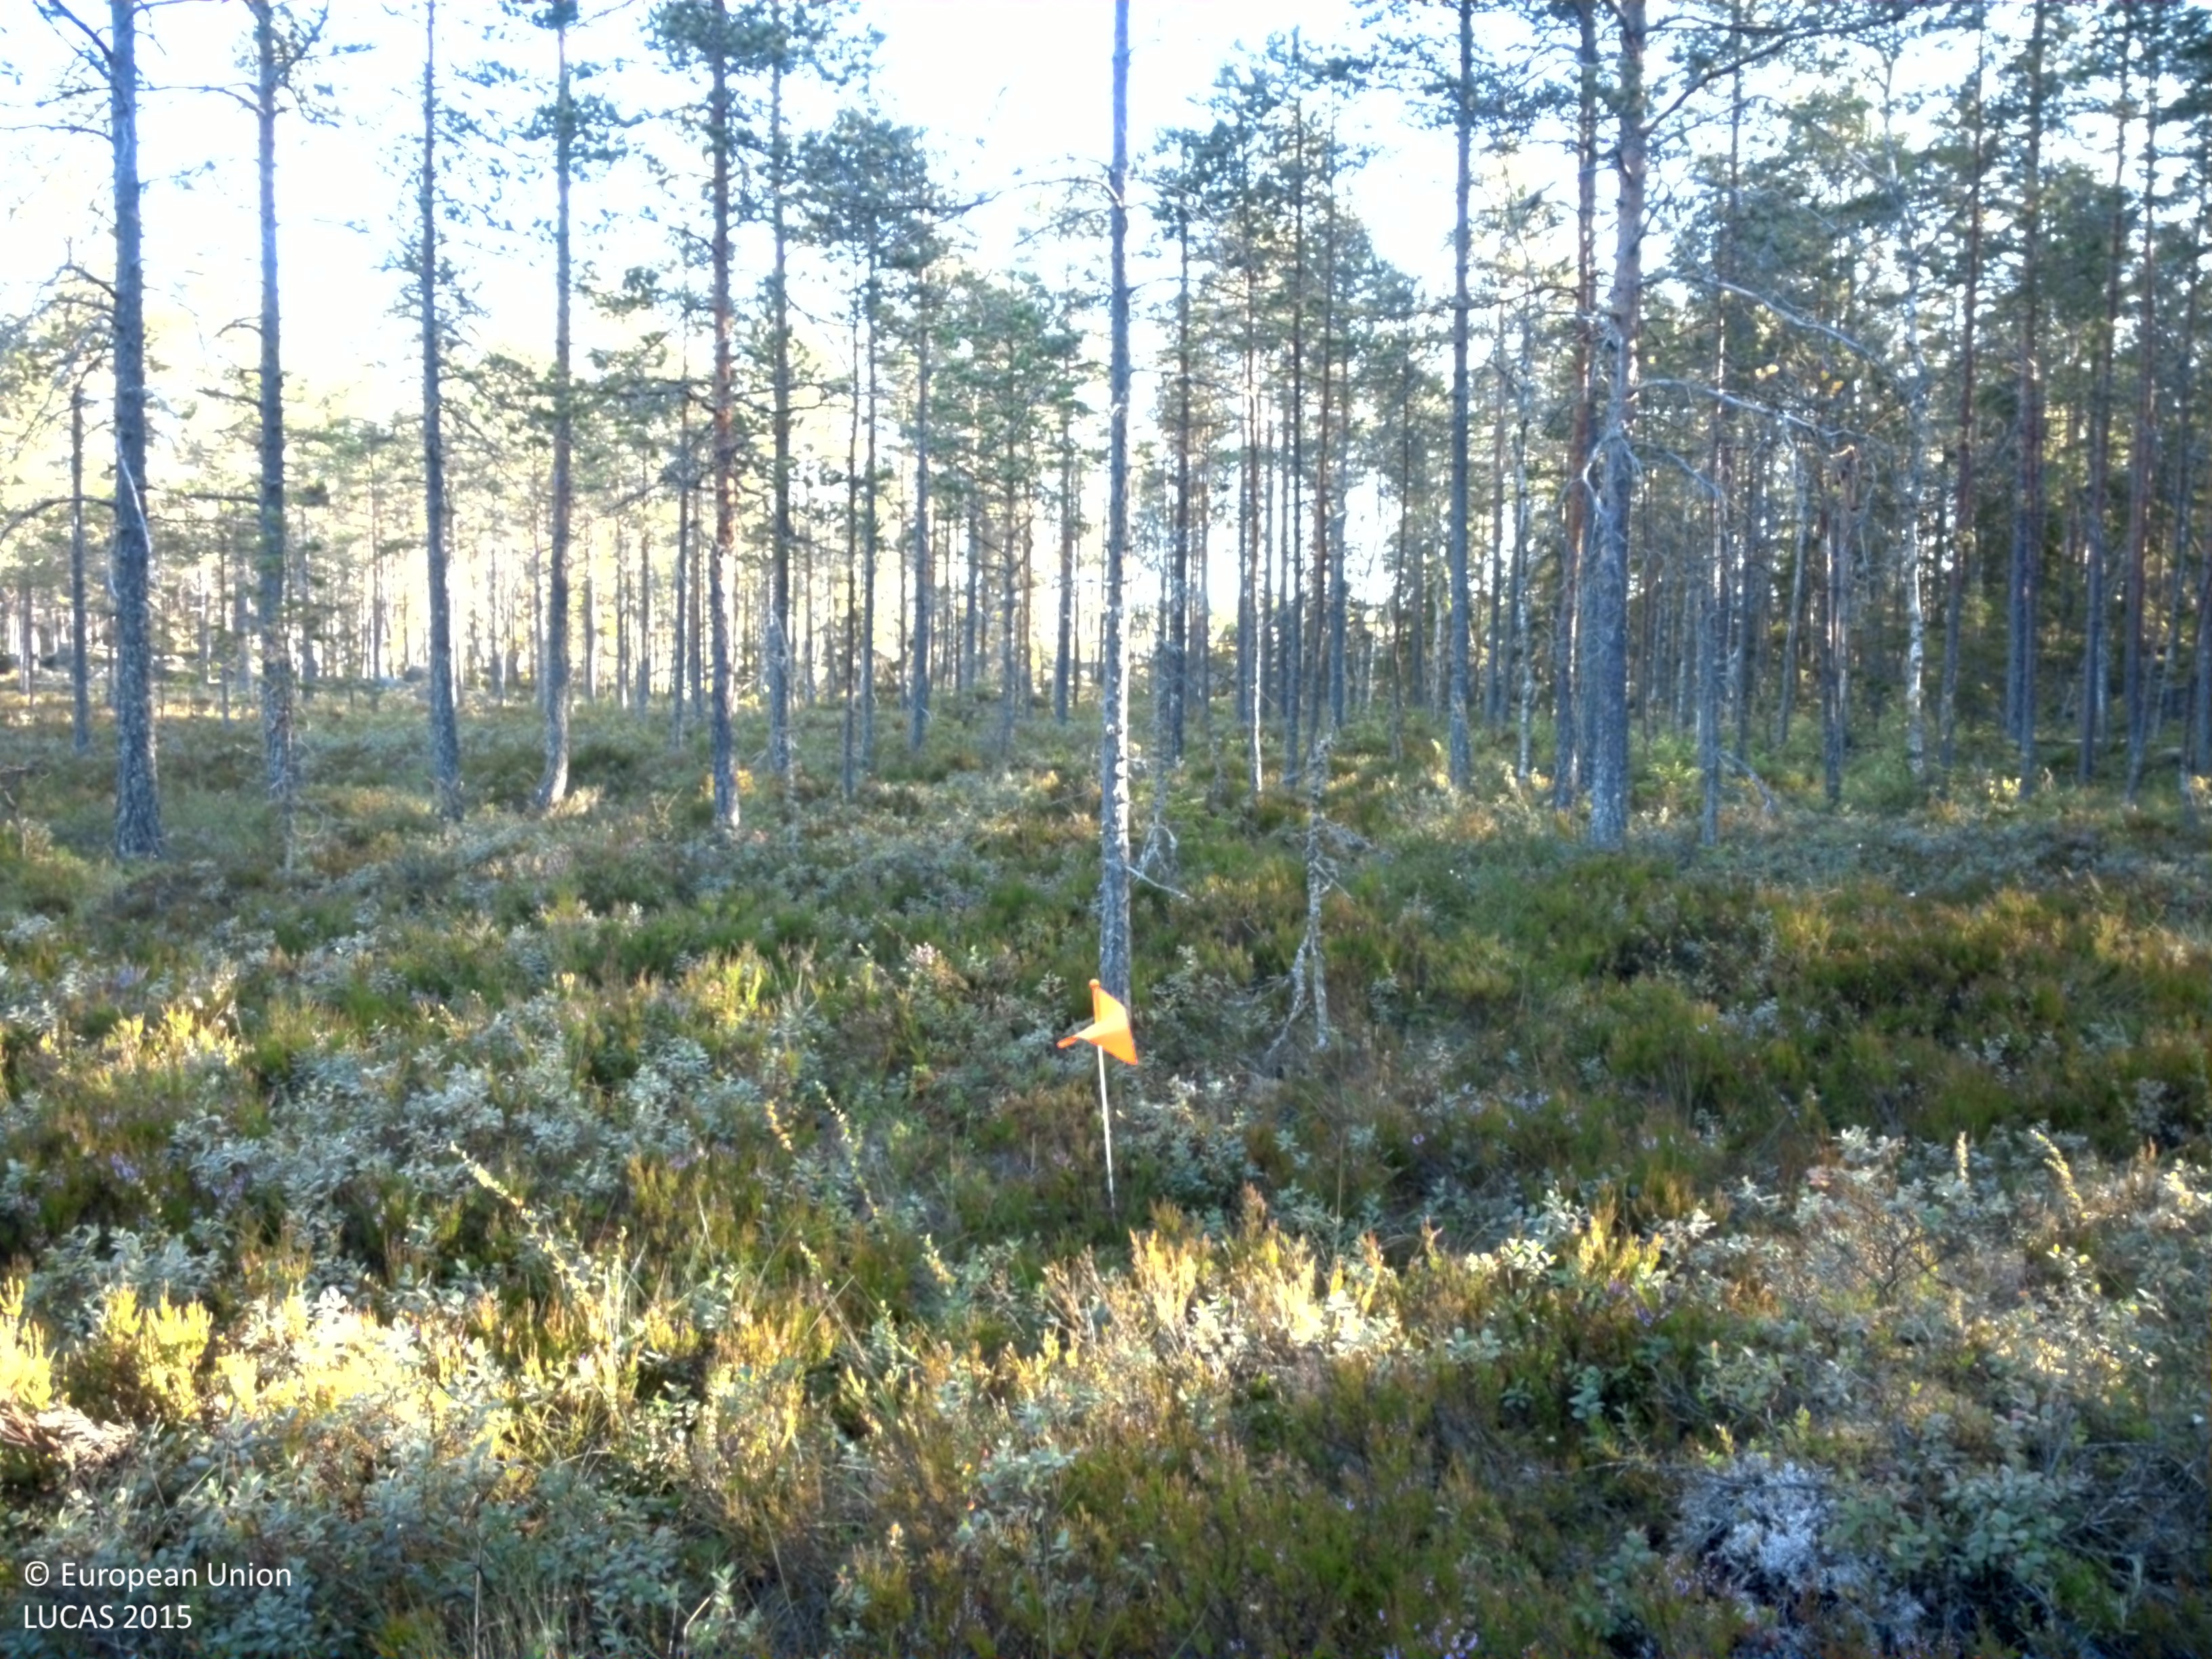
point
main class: Woodland
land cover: Pine dominated coniferous woodland
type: boreal forest
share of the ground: 25 - 50 %
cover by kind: coniferous forest trees 40 %, shrubs 40 %, lichens and mosses 20 %
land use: Semi-natural and natural areas not in use
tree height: > 5 m
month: August
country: SE
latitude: 59.9031
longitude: 14.1557
